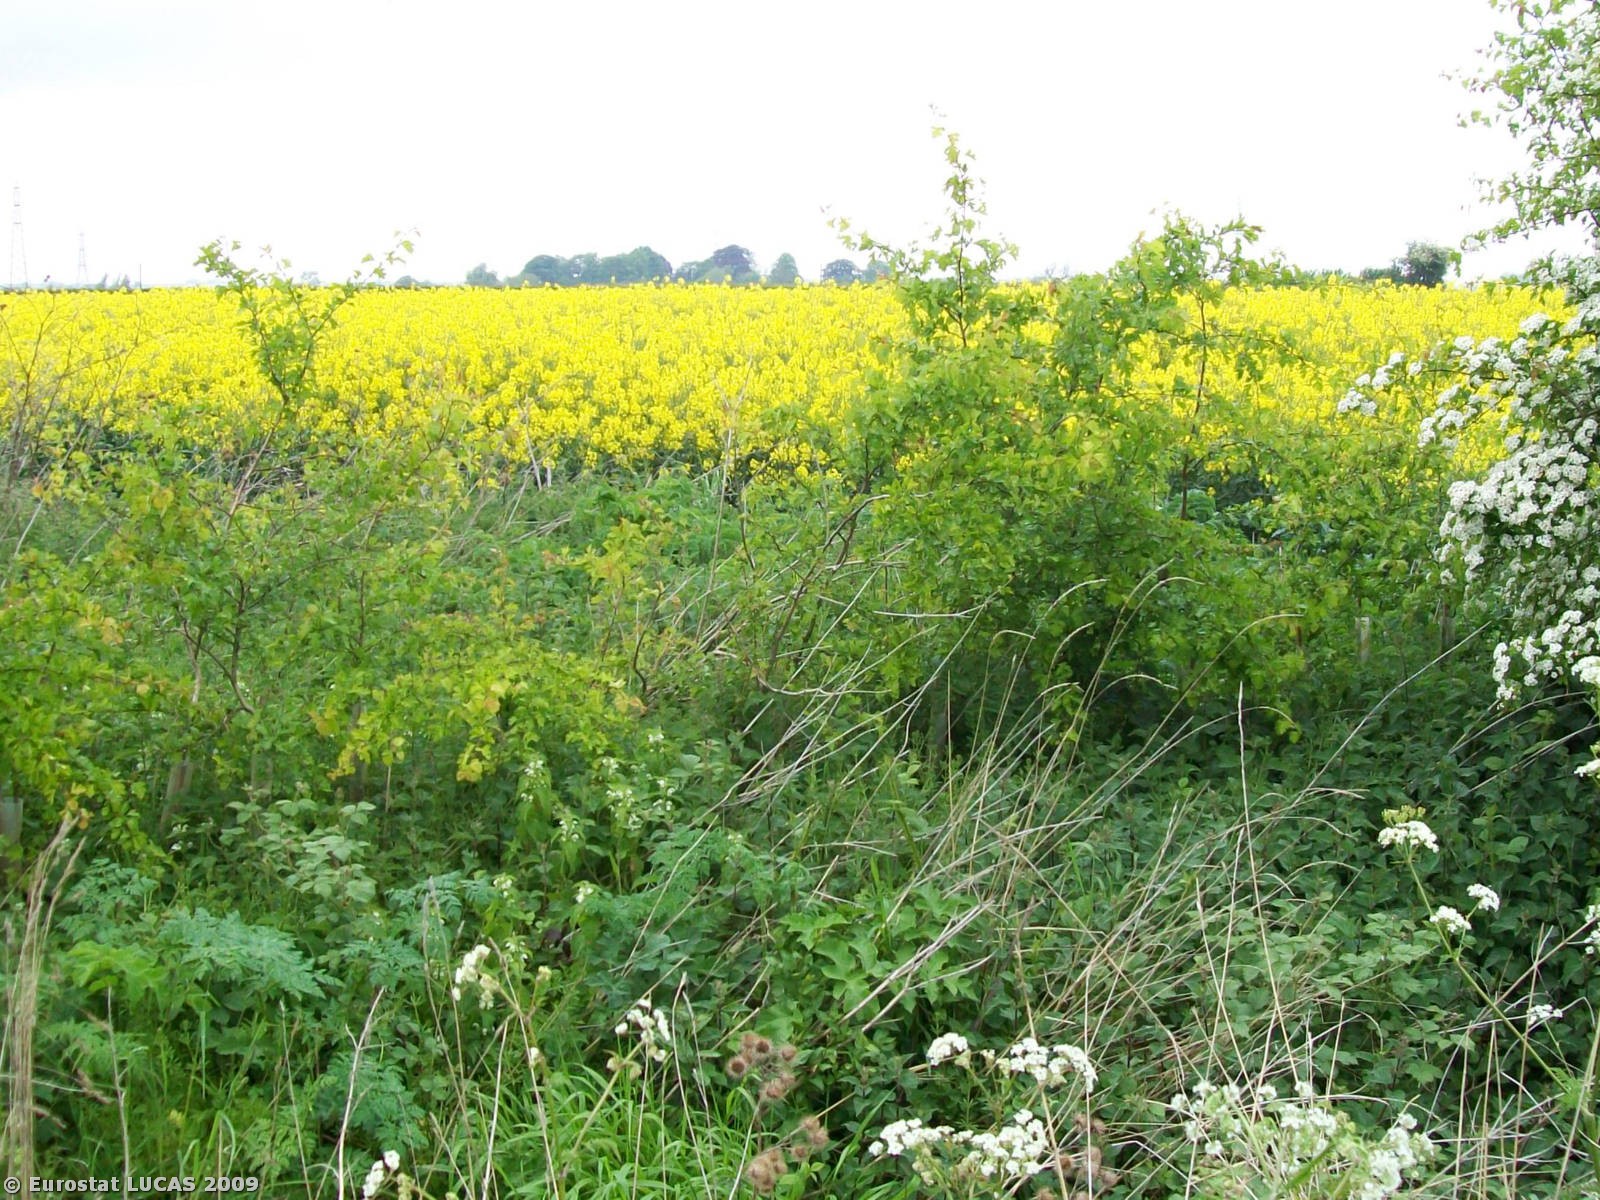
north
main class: Cropland
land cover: Common wheat
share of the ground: > 75 %
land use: Agriculture (excluding fallow land and kitchen gardens)
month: May
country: GB
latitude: 52.9277
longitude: -0.8869
